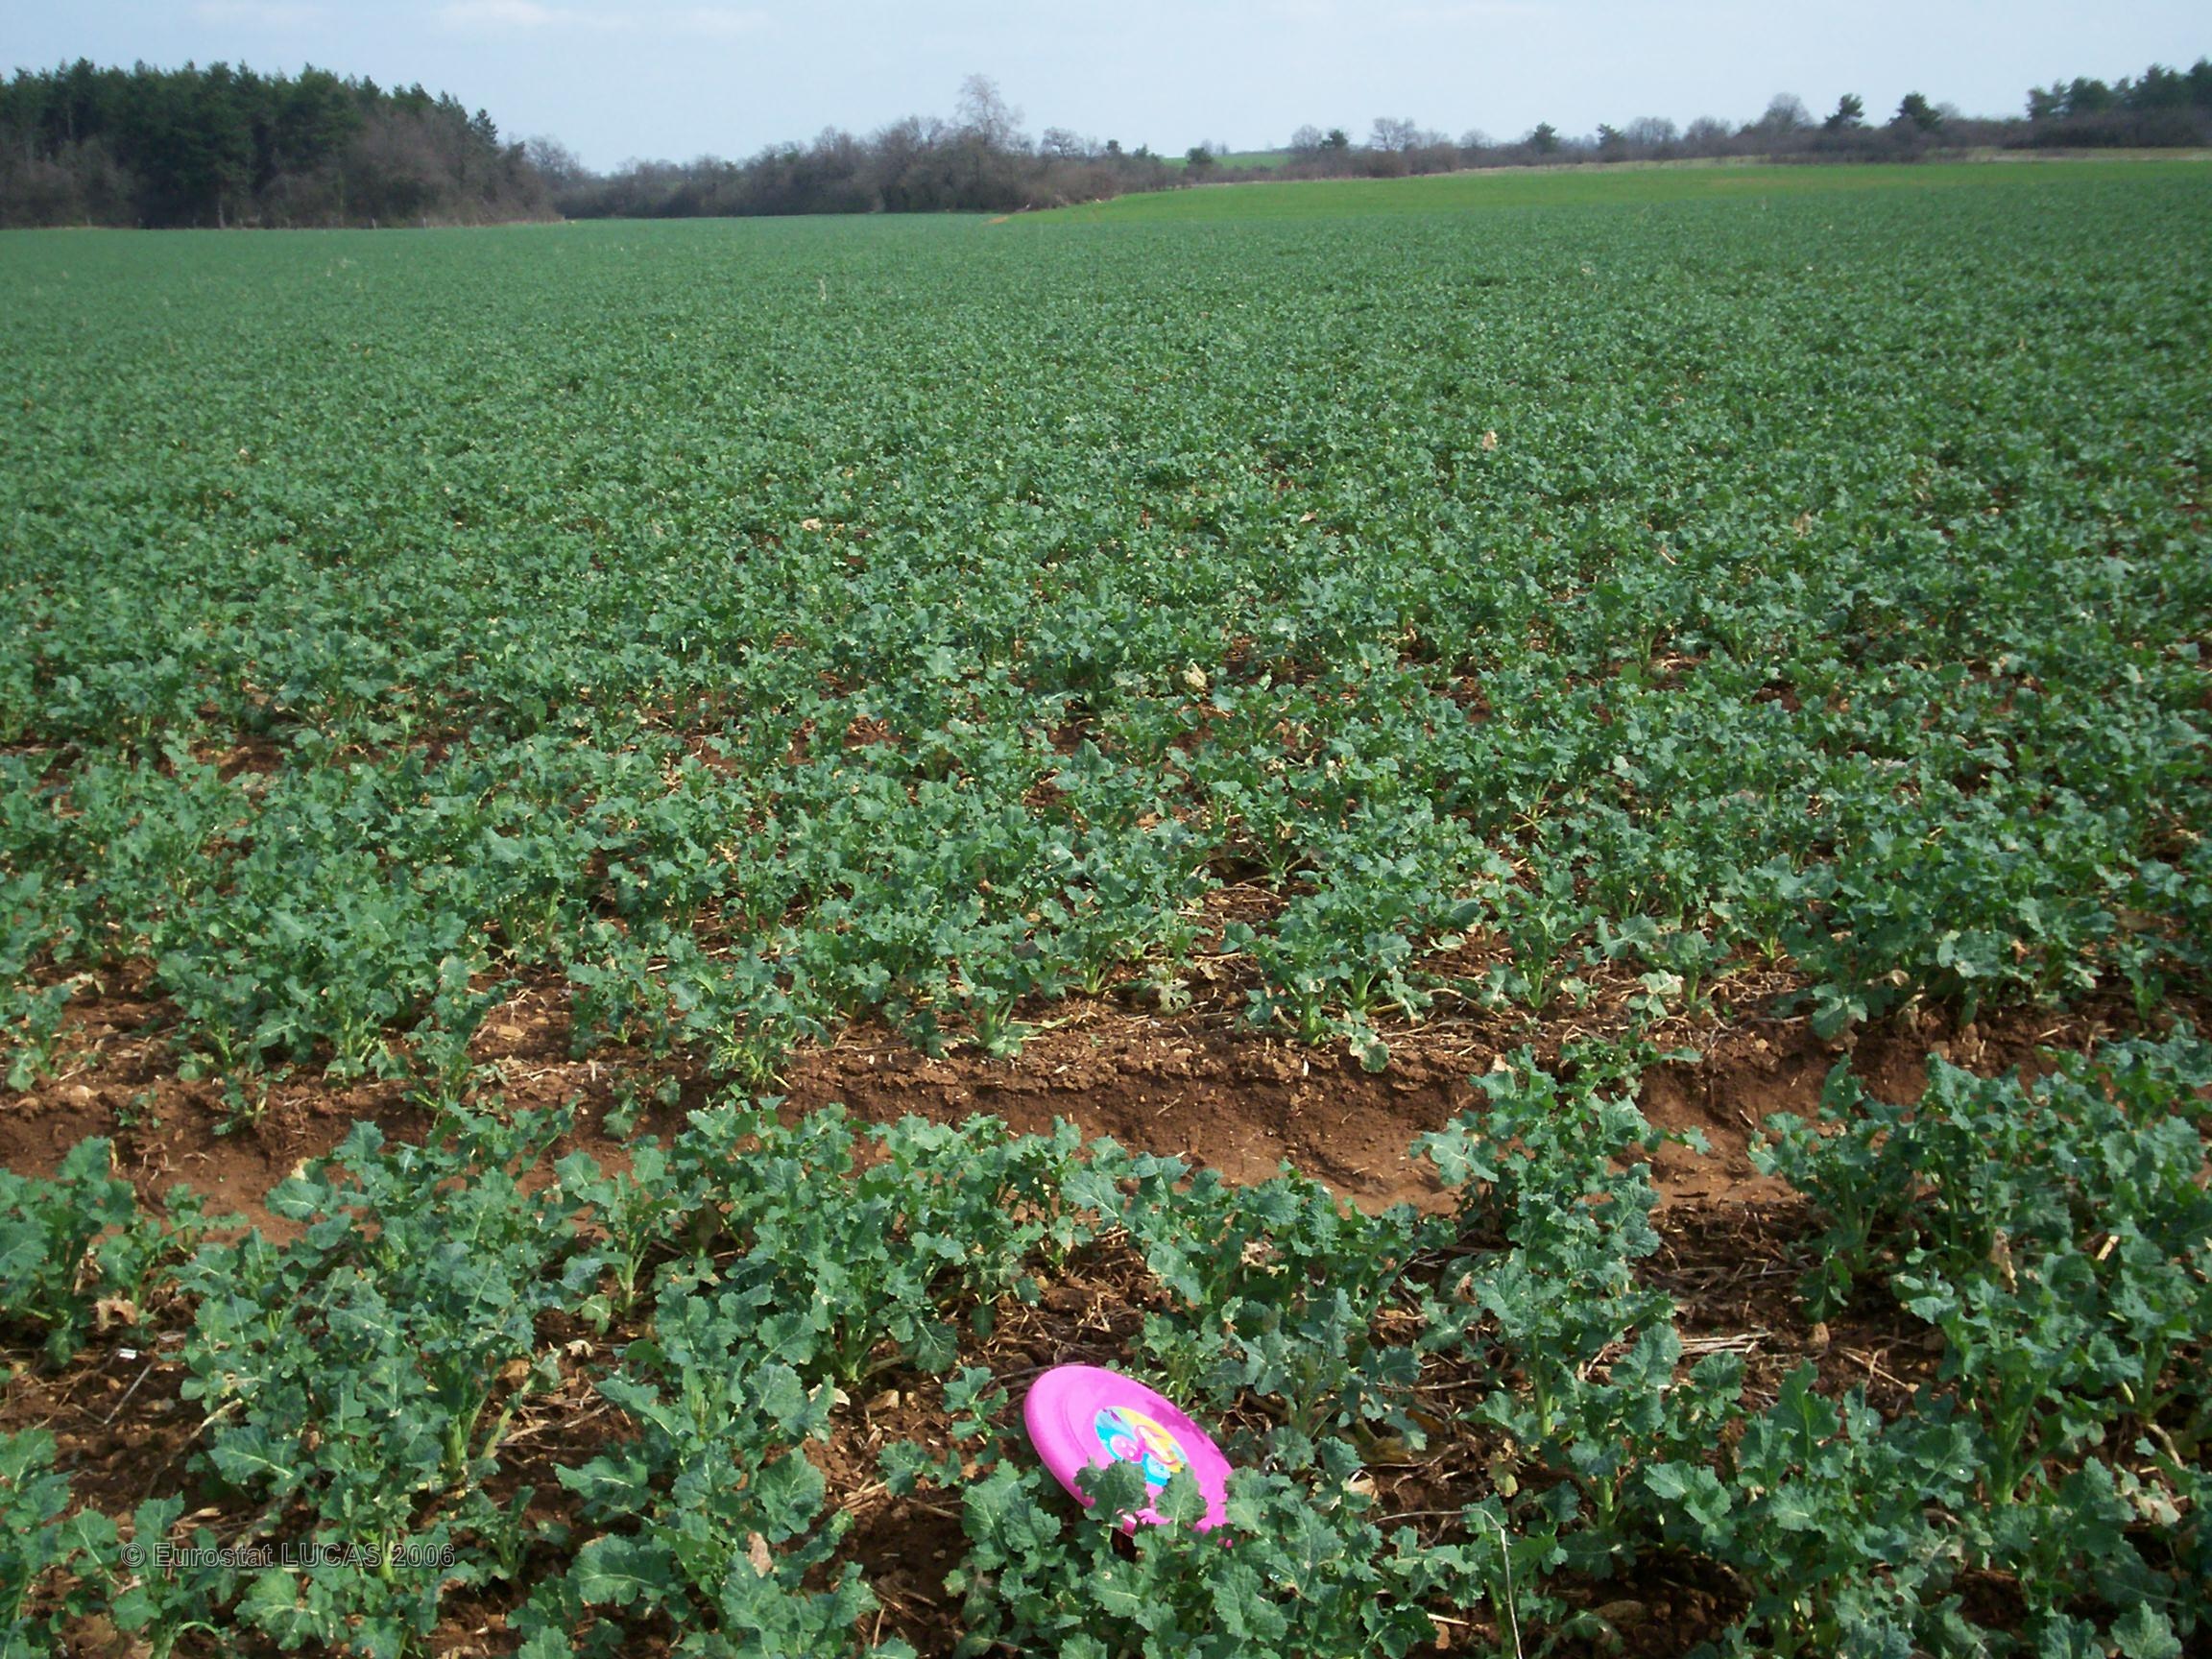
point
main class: Cropland
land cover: Rape and turnip rape
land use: Agriculture (excluding fallow land and kitchen gardens)
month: April
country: FR
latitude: 47.8163
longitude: 5.2855
